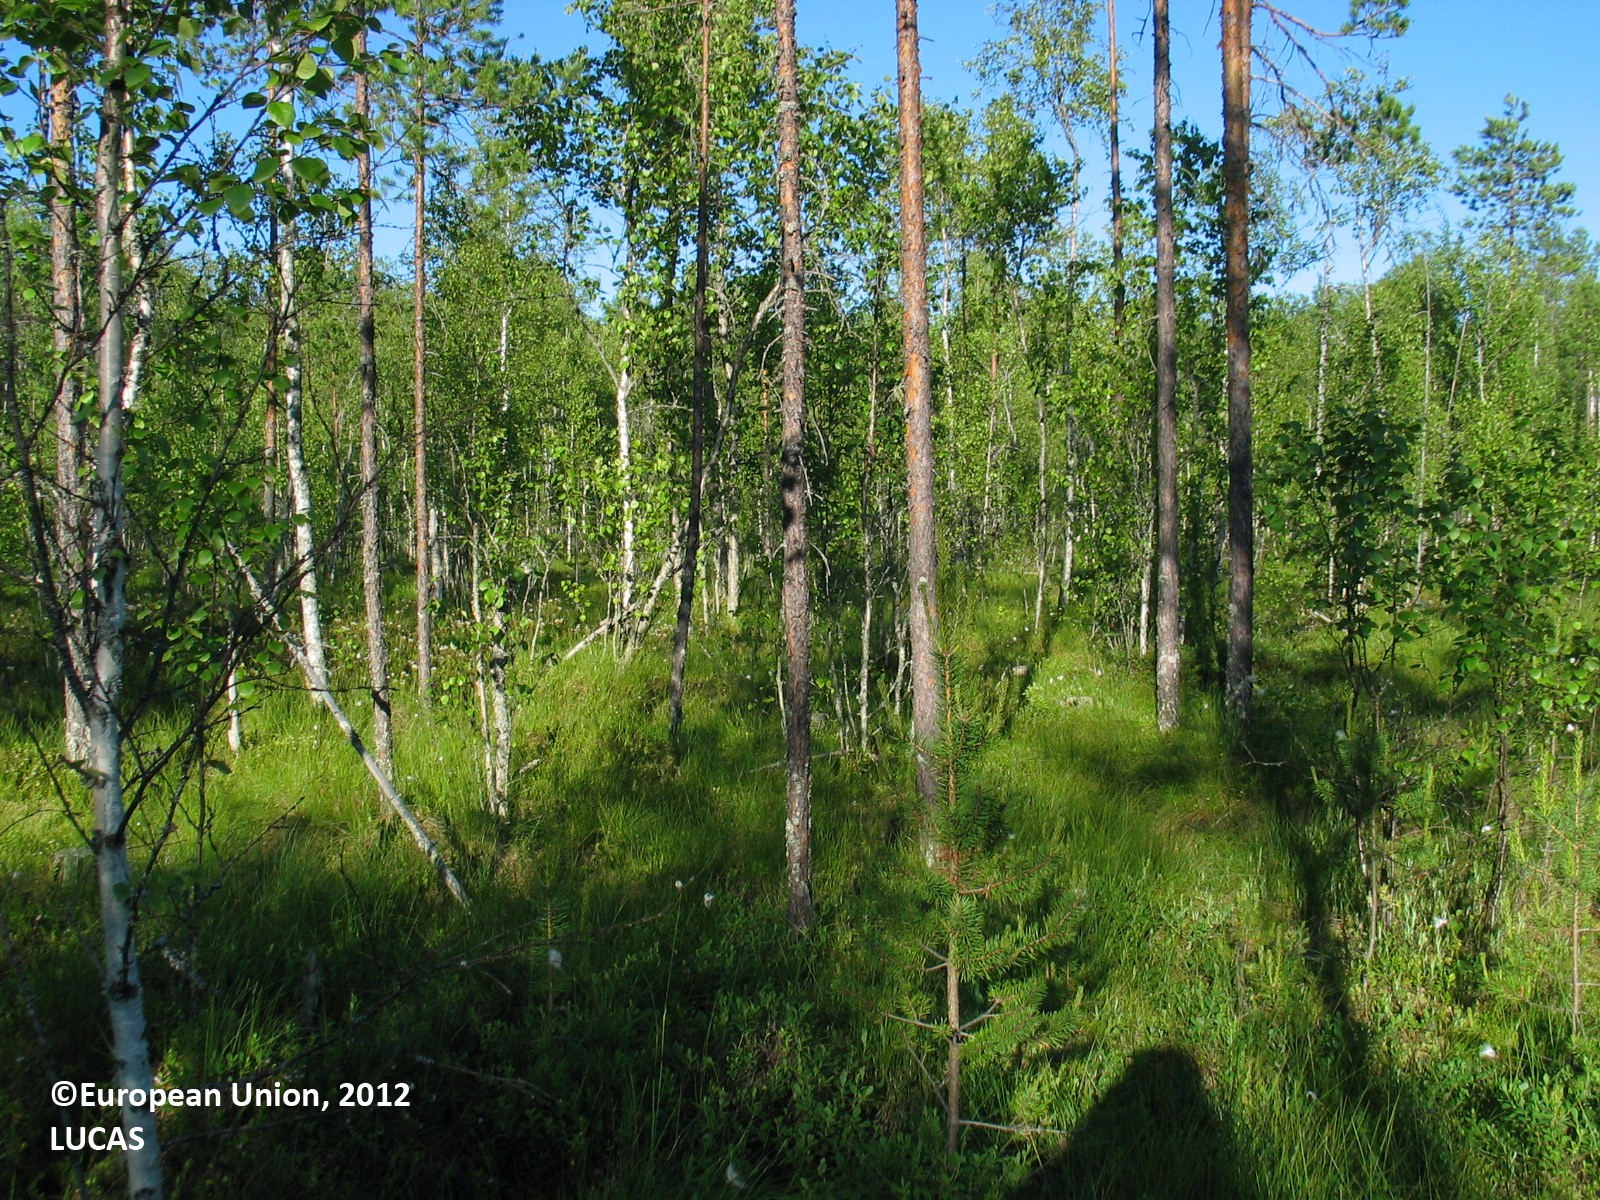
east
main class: Woodland
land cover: Other mixed woodland
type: mire and swamp forests
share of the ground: 10 - 25 %
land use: Forestry
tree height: > 5 m
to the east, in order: Other mixed woodland; Broadleaved woodland; Ditches and canals; Broadleaved woodland; Ditches and canals; Broadleaved woodland; Ditches and canals; Broadleaved woodland; Ditches and canals; Broadleaved woodland; Ditches and canals; Other mixed woodland; Ditches and canals; Other mixed woodland
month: July
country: FI
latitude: 64.7648
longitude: 26.5302
